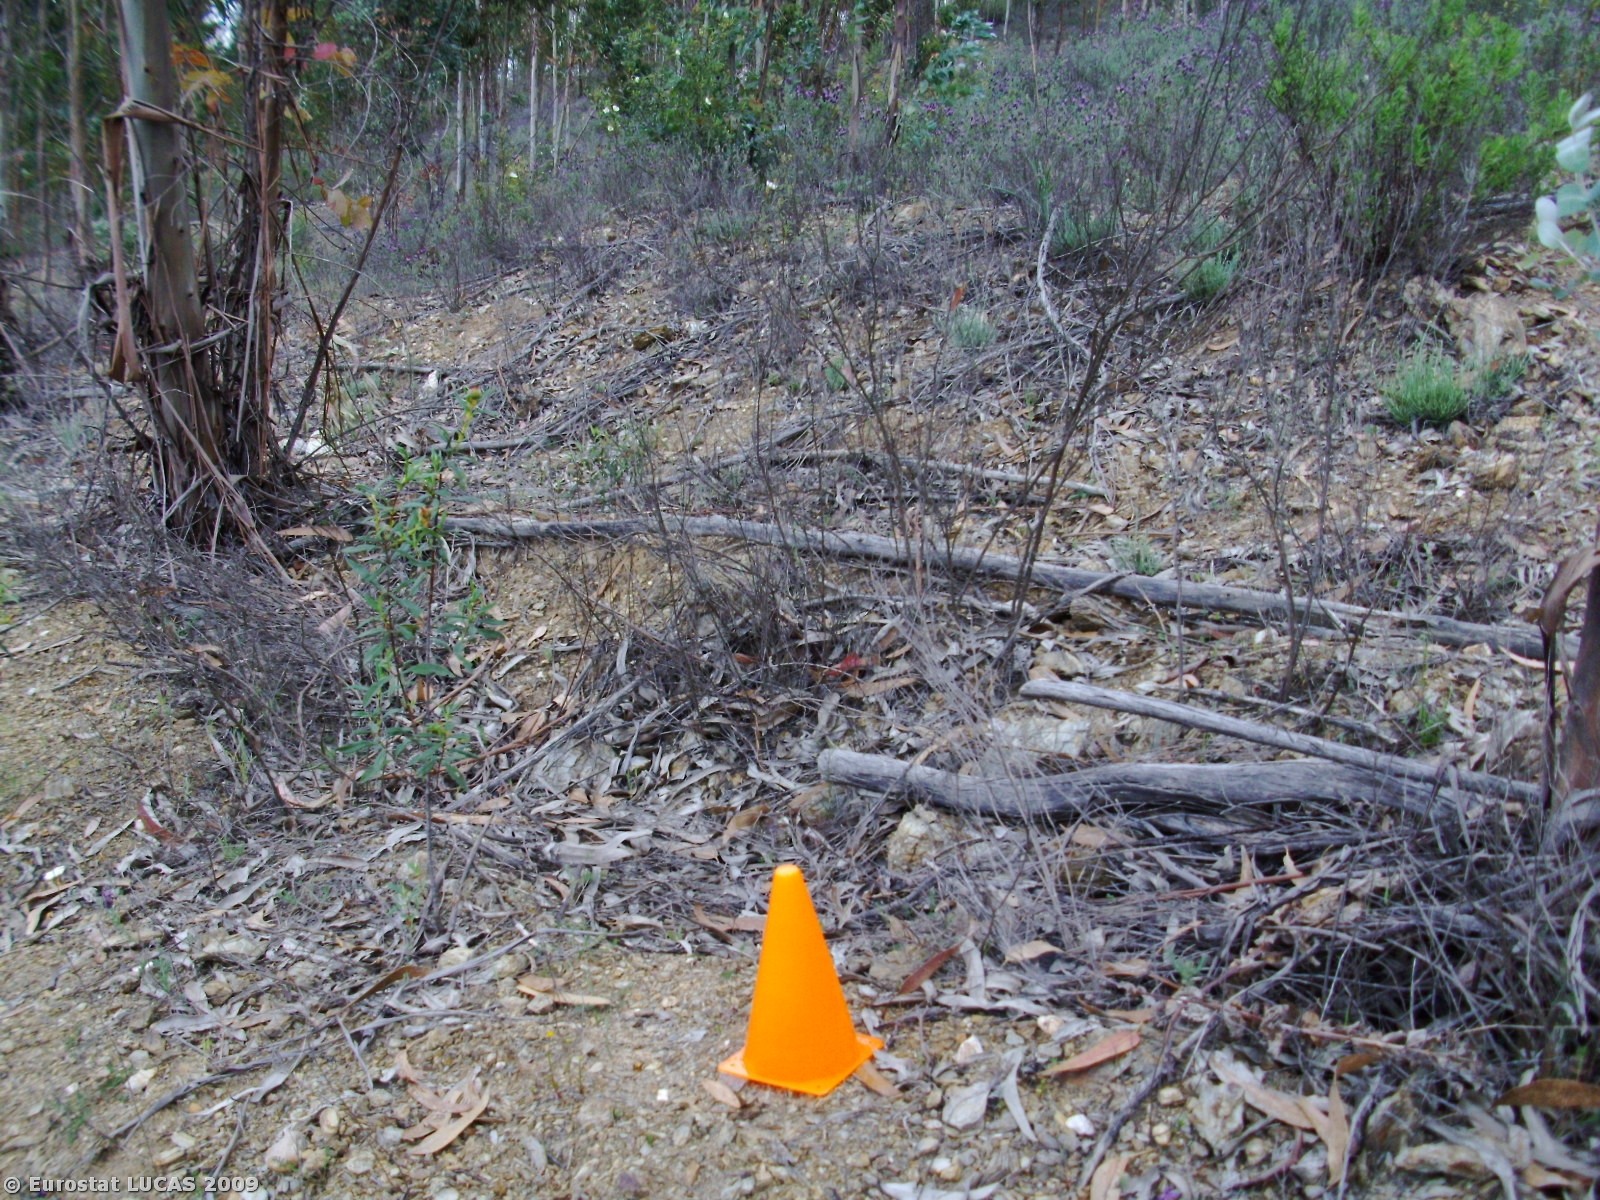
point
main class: Woodland
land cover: Broadleaved woodland
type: plantations and self-sown exotic forest
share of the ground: 50 - 75 %
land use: Forestry
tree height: > 5 m
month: April
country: PT
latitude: 39.6511
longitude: -7.5435
